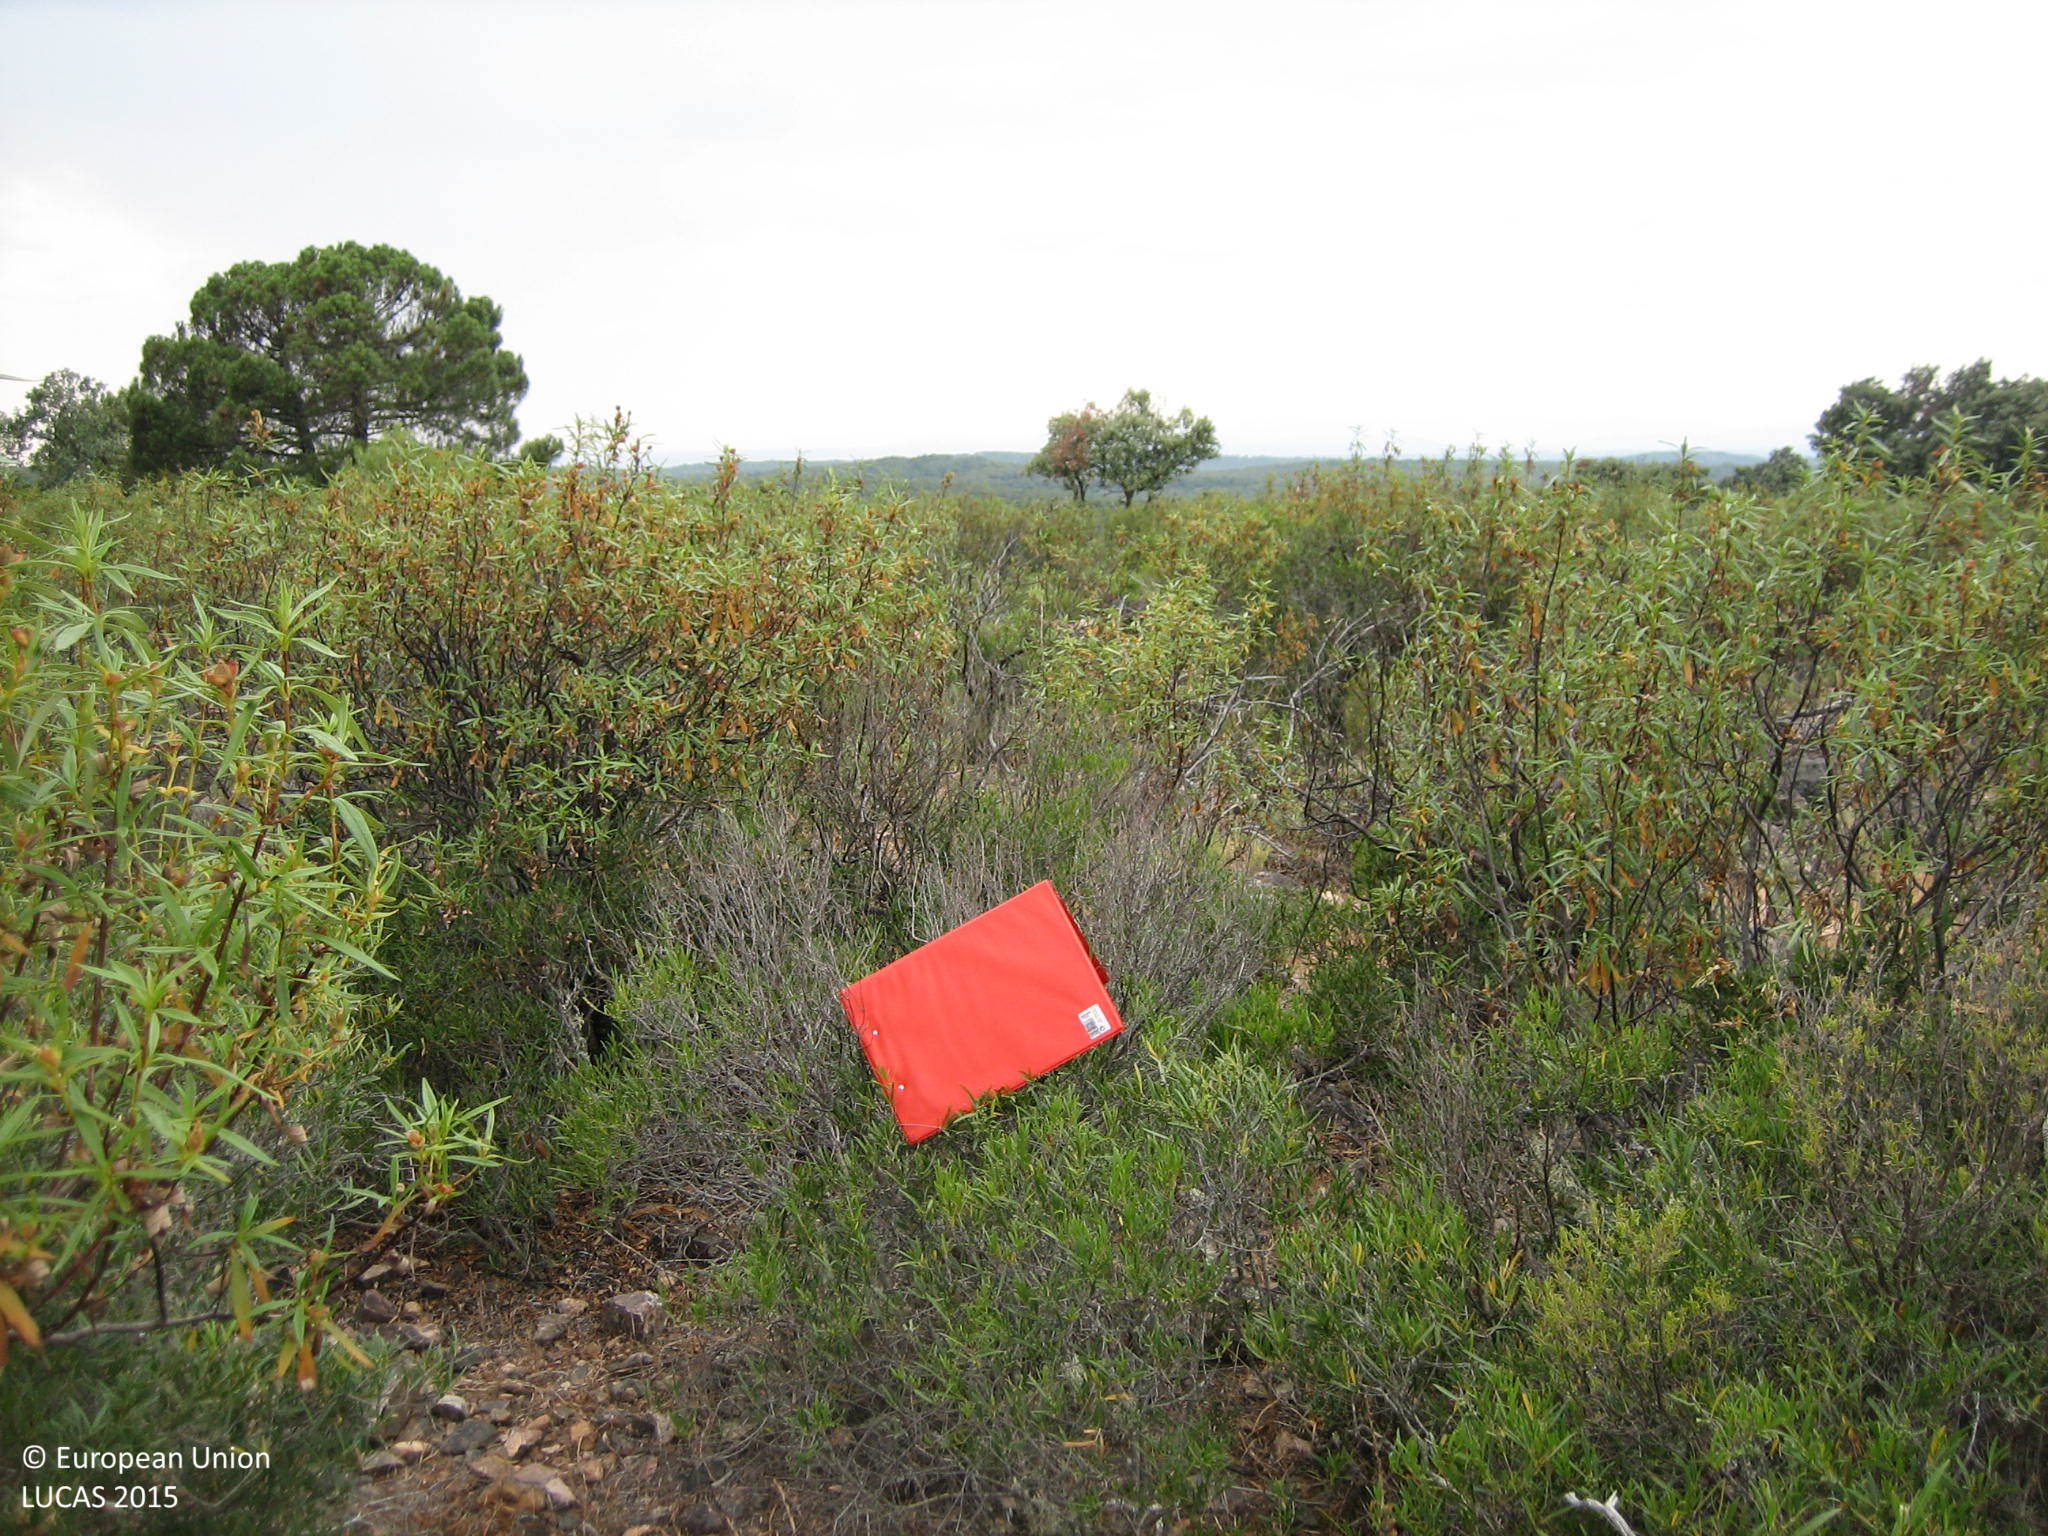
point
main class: Shrubland
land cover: Shrubland without tree cover
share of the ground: > 75 %
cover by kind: shrubs 100 %
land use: Semi-natural and natural areas not in use
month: June
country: ES
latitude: 39.2857
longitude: -4.9132
